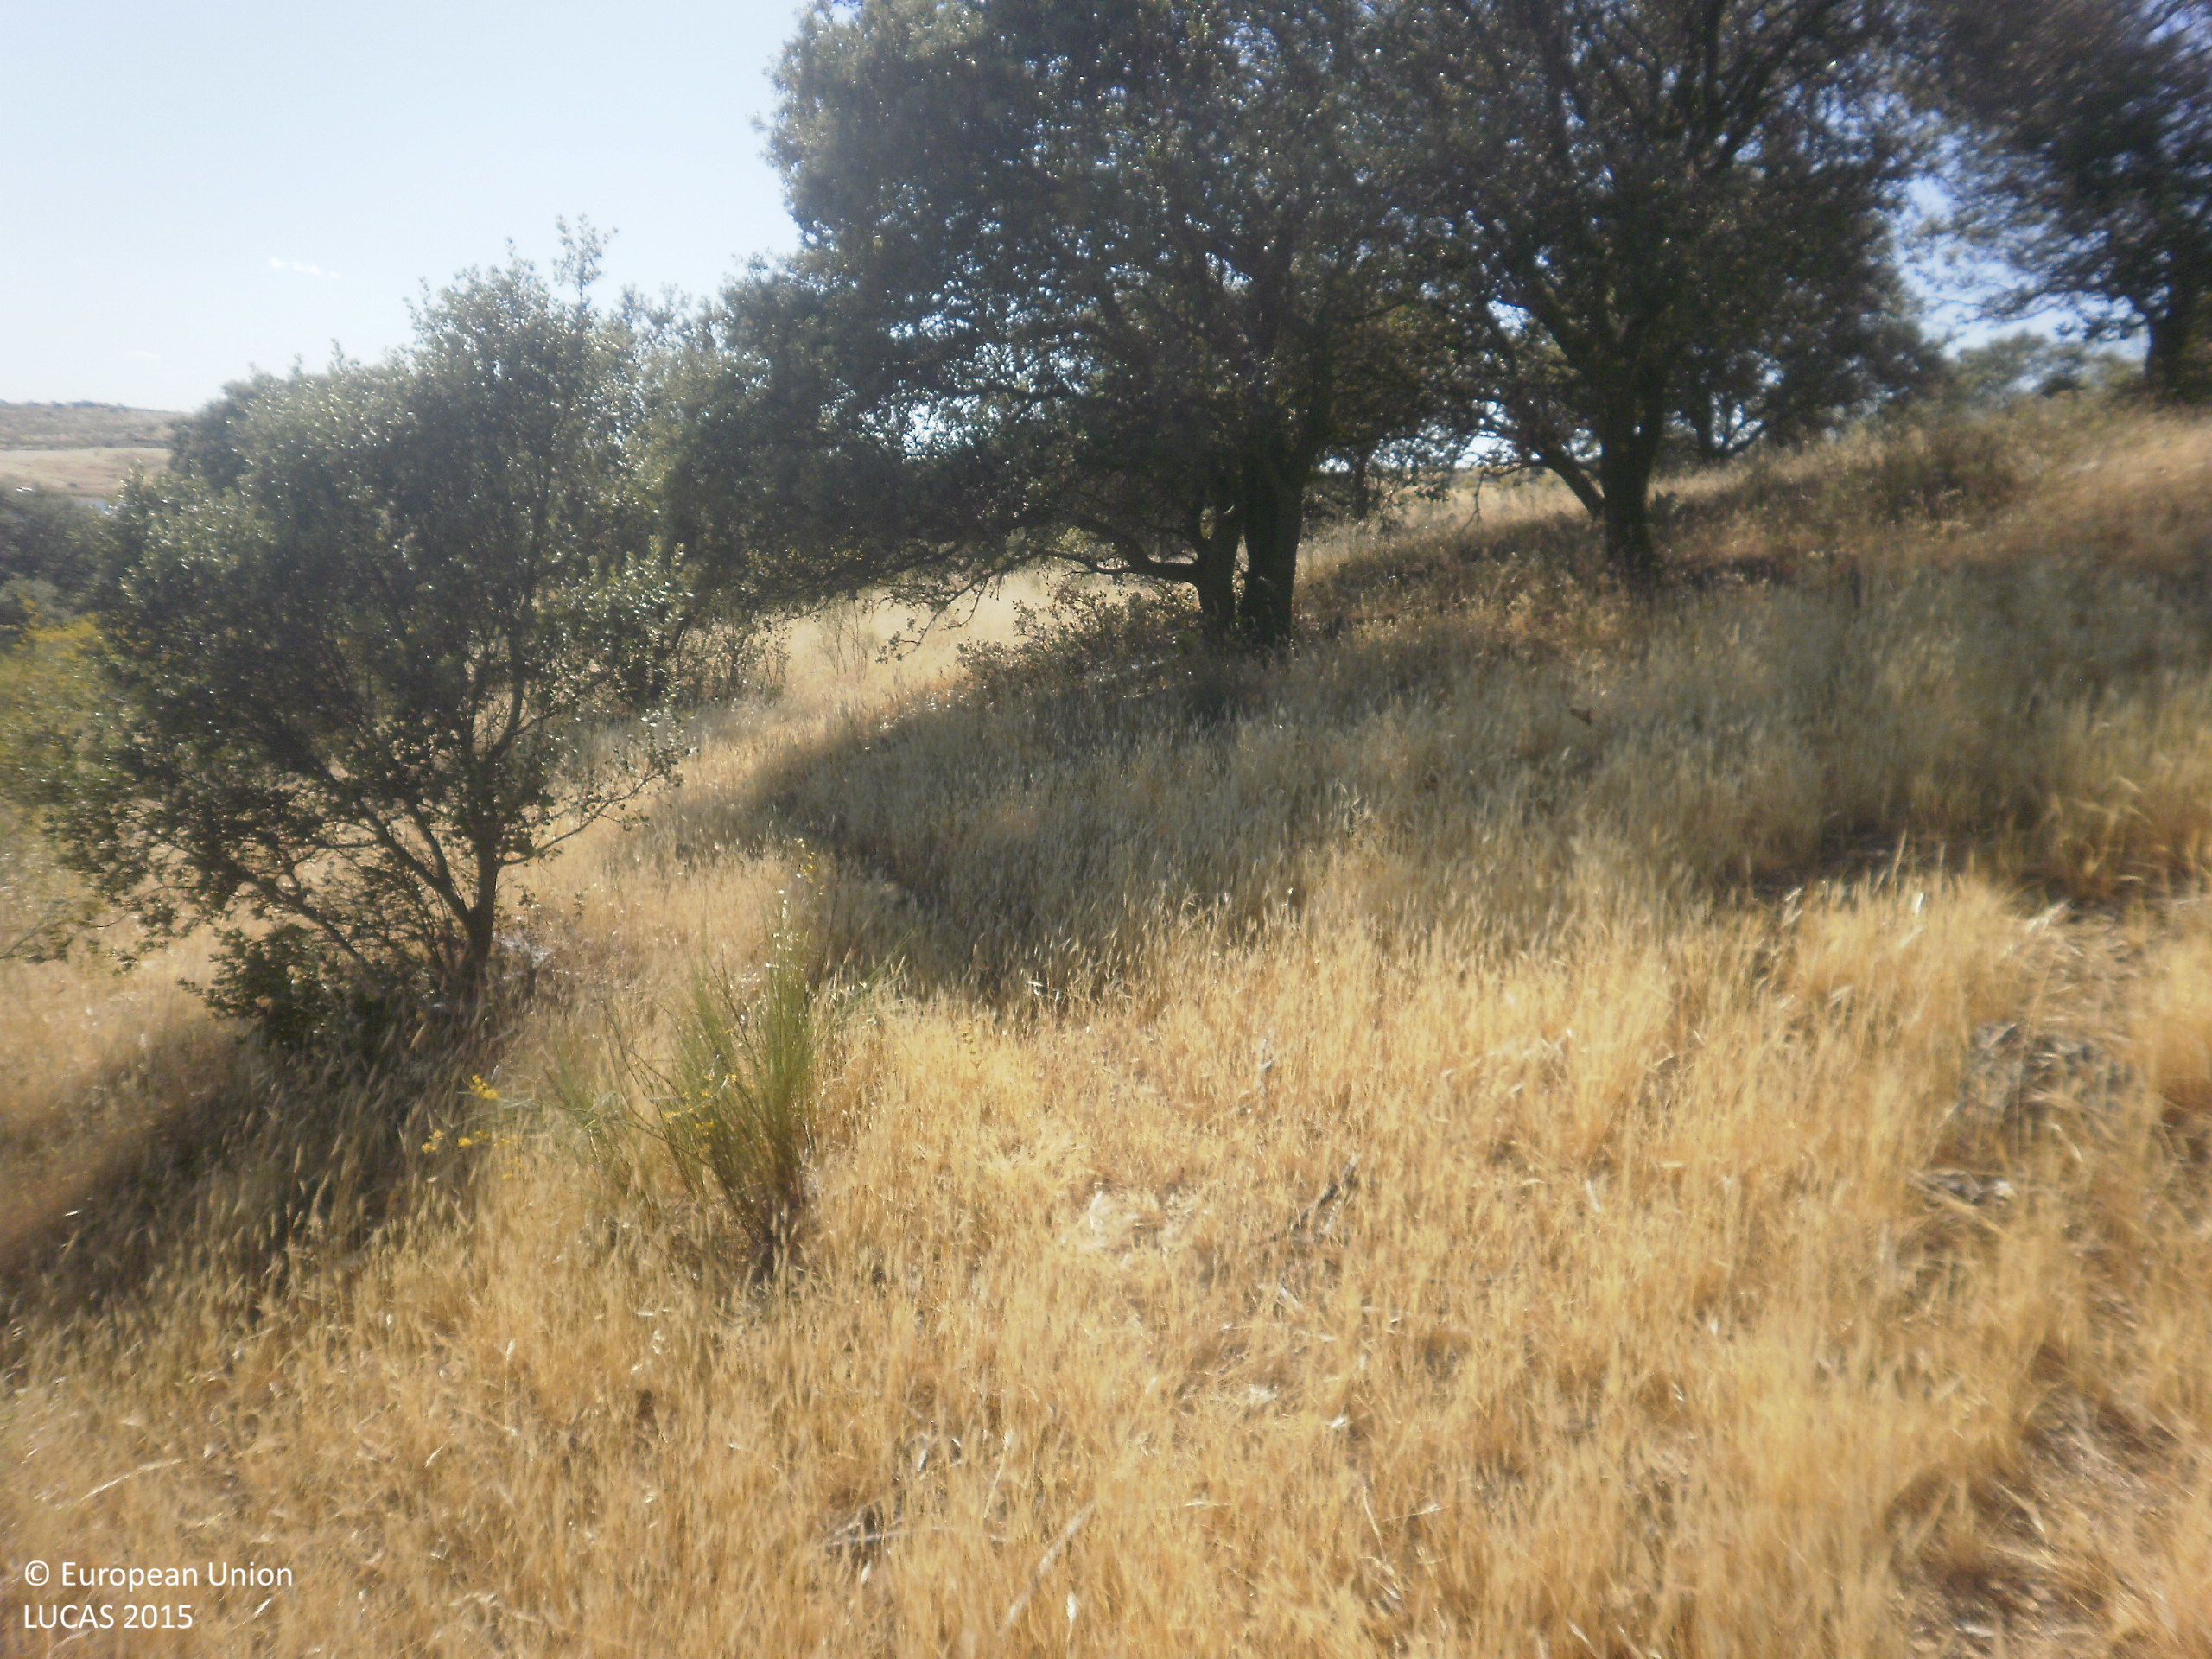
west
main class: Shrubland
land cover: Shrubland with sparse tree cover
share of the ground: 25 - 50 %
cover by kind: shrubs 90 %, broadleaved forest trees 5 %, herbaceous plants 5 %
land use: Agriculture (excluding fallow land and kitchen gardens)
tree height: < 5 m
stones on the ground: < 10 %
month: May
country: ES
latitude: 39.0972
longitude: -5.2929
